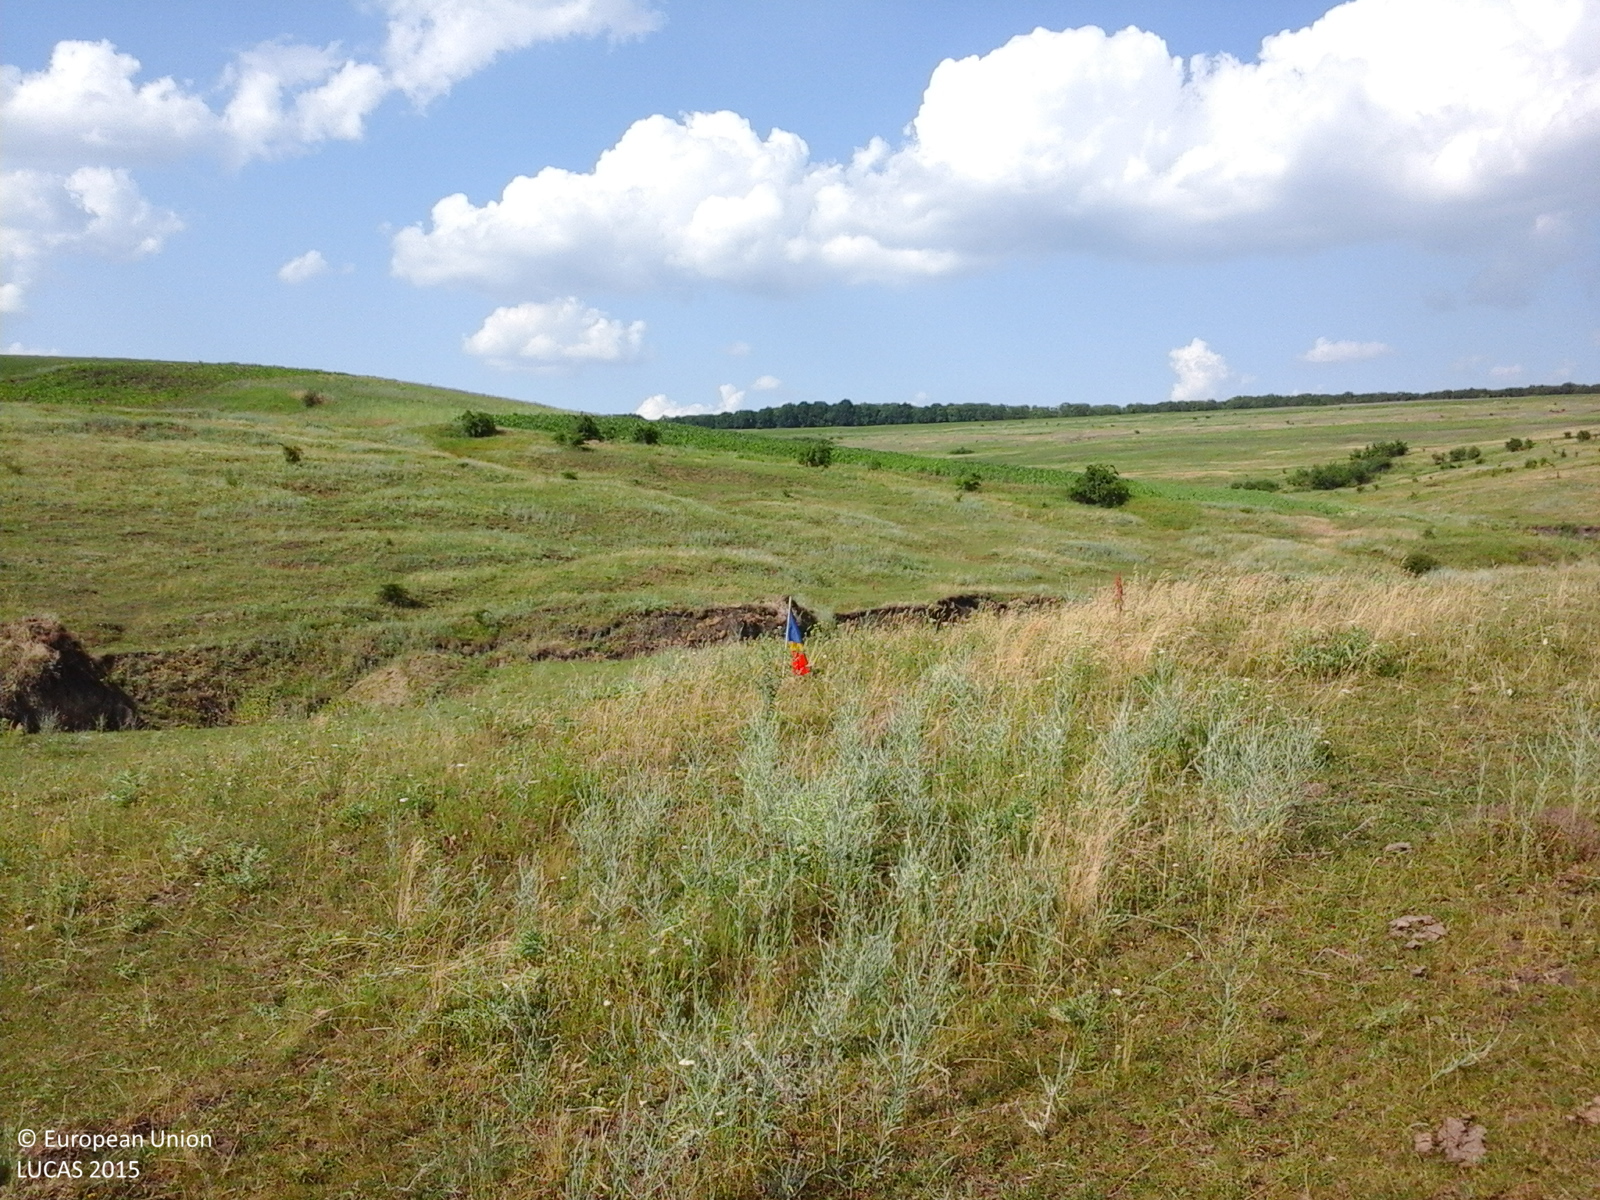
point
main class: Grassland
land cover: Grassland without tree/shrub cover
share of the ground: > 75 %
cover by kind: herbaceous plants 100 %
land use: Agriculture (excluding fallow land and kitchen gardens)
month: June
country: RO
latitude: 47.6044
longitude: 26.9008
